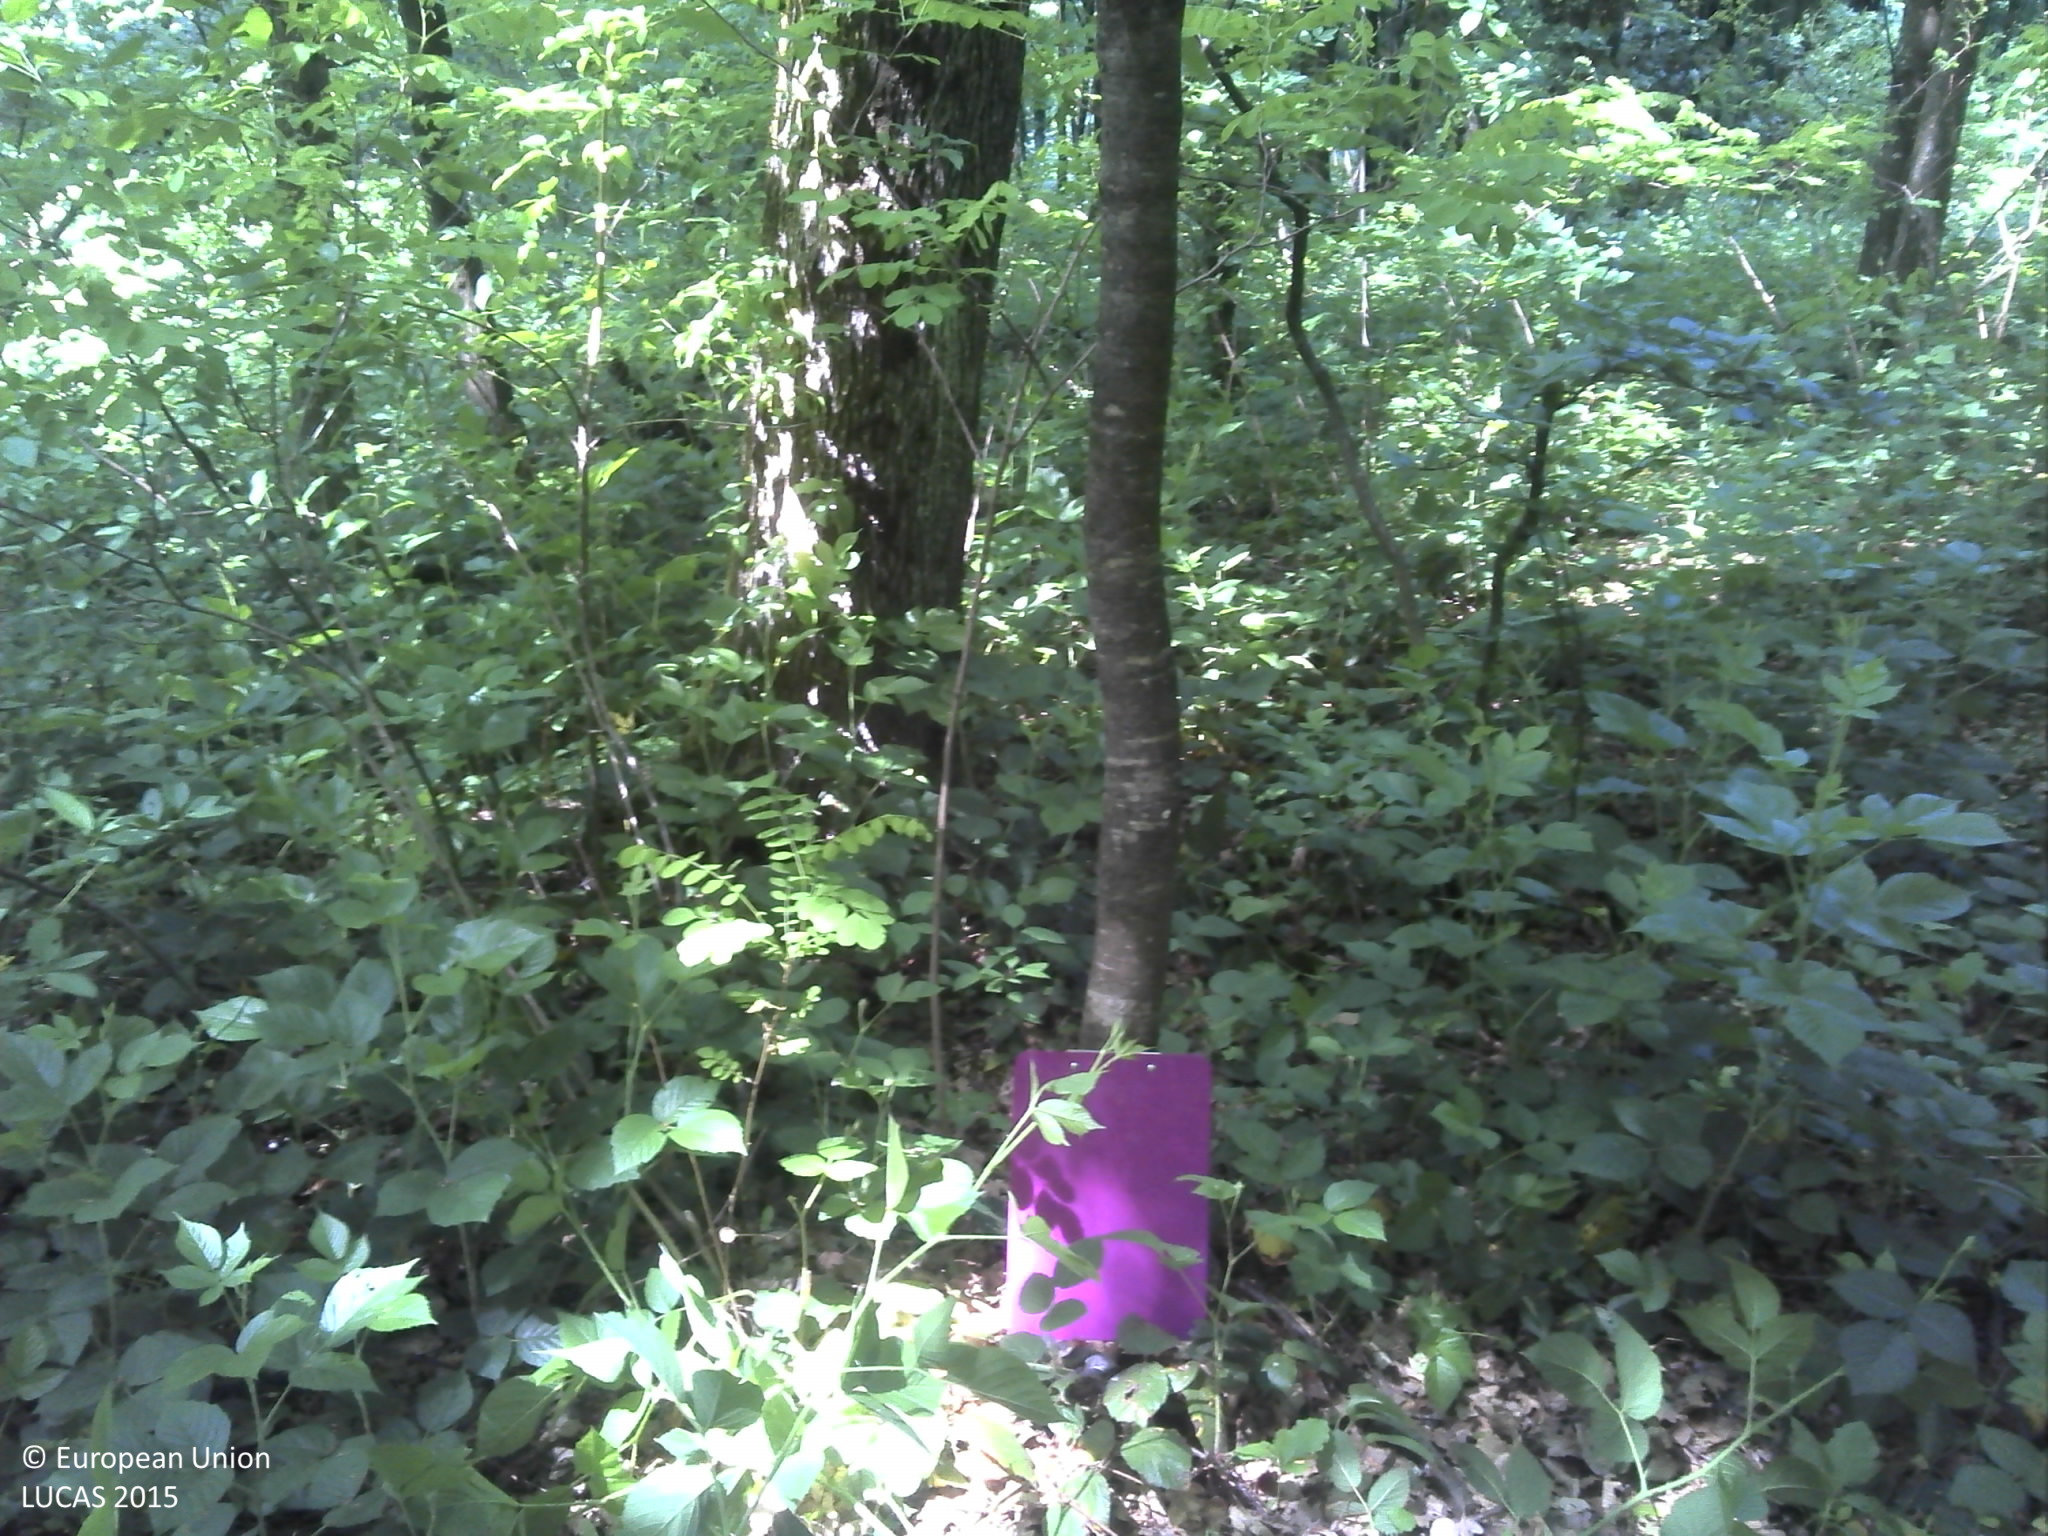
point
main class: Woodland
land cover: Broadleaved woodland
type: acidophilous oak and oak-birch forest
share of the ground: > 75 %
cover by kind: broadleaved forest trees 80 %, lichens and mosses 20 %
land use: Forestry
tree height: > 5 m
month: May
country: HR
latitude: 45.2716
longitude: 18.2508
